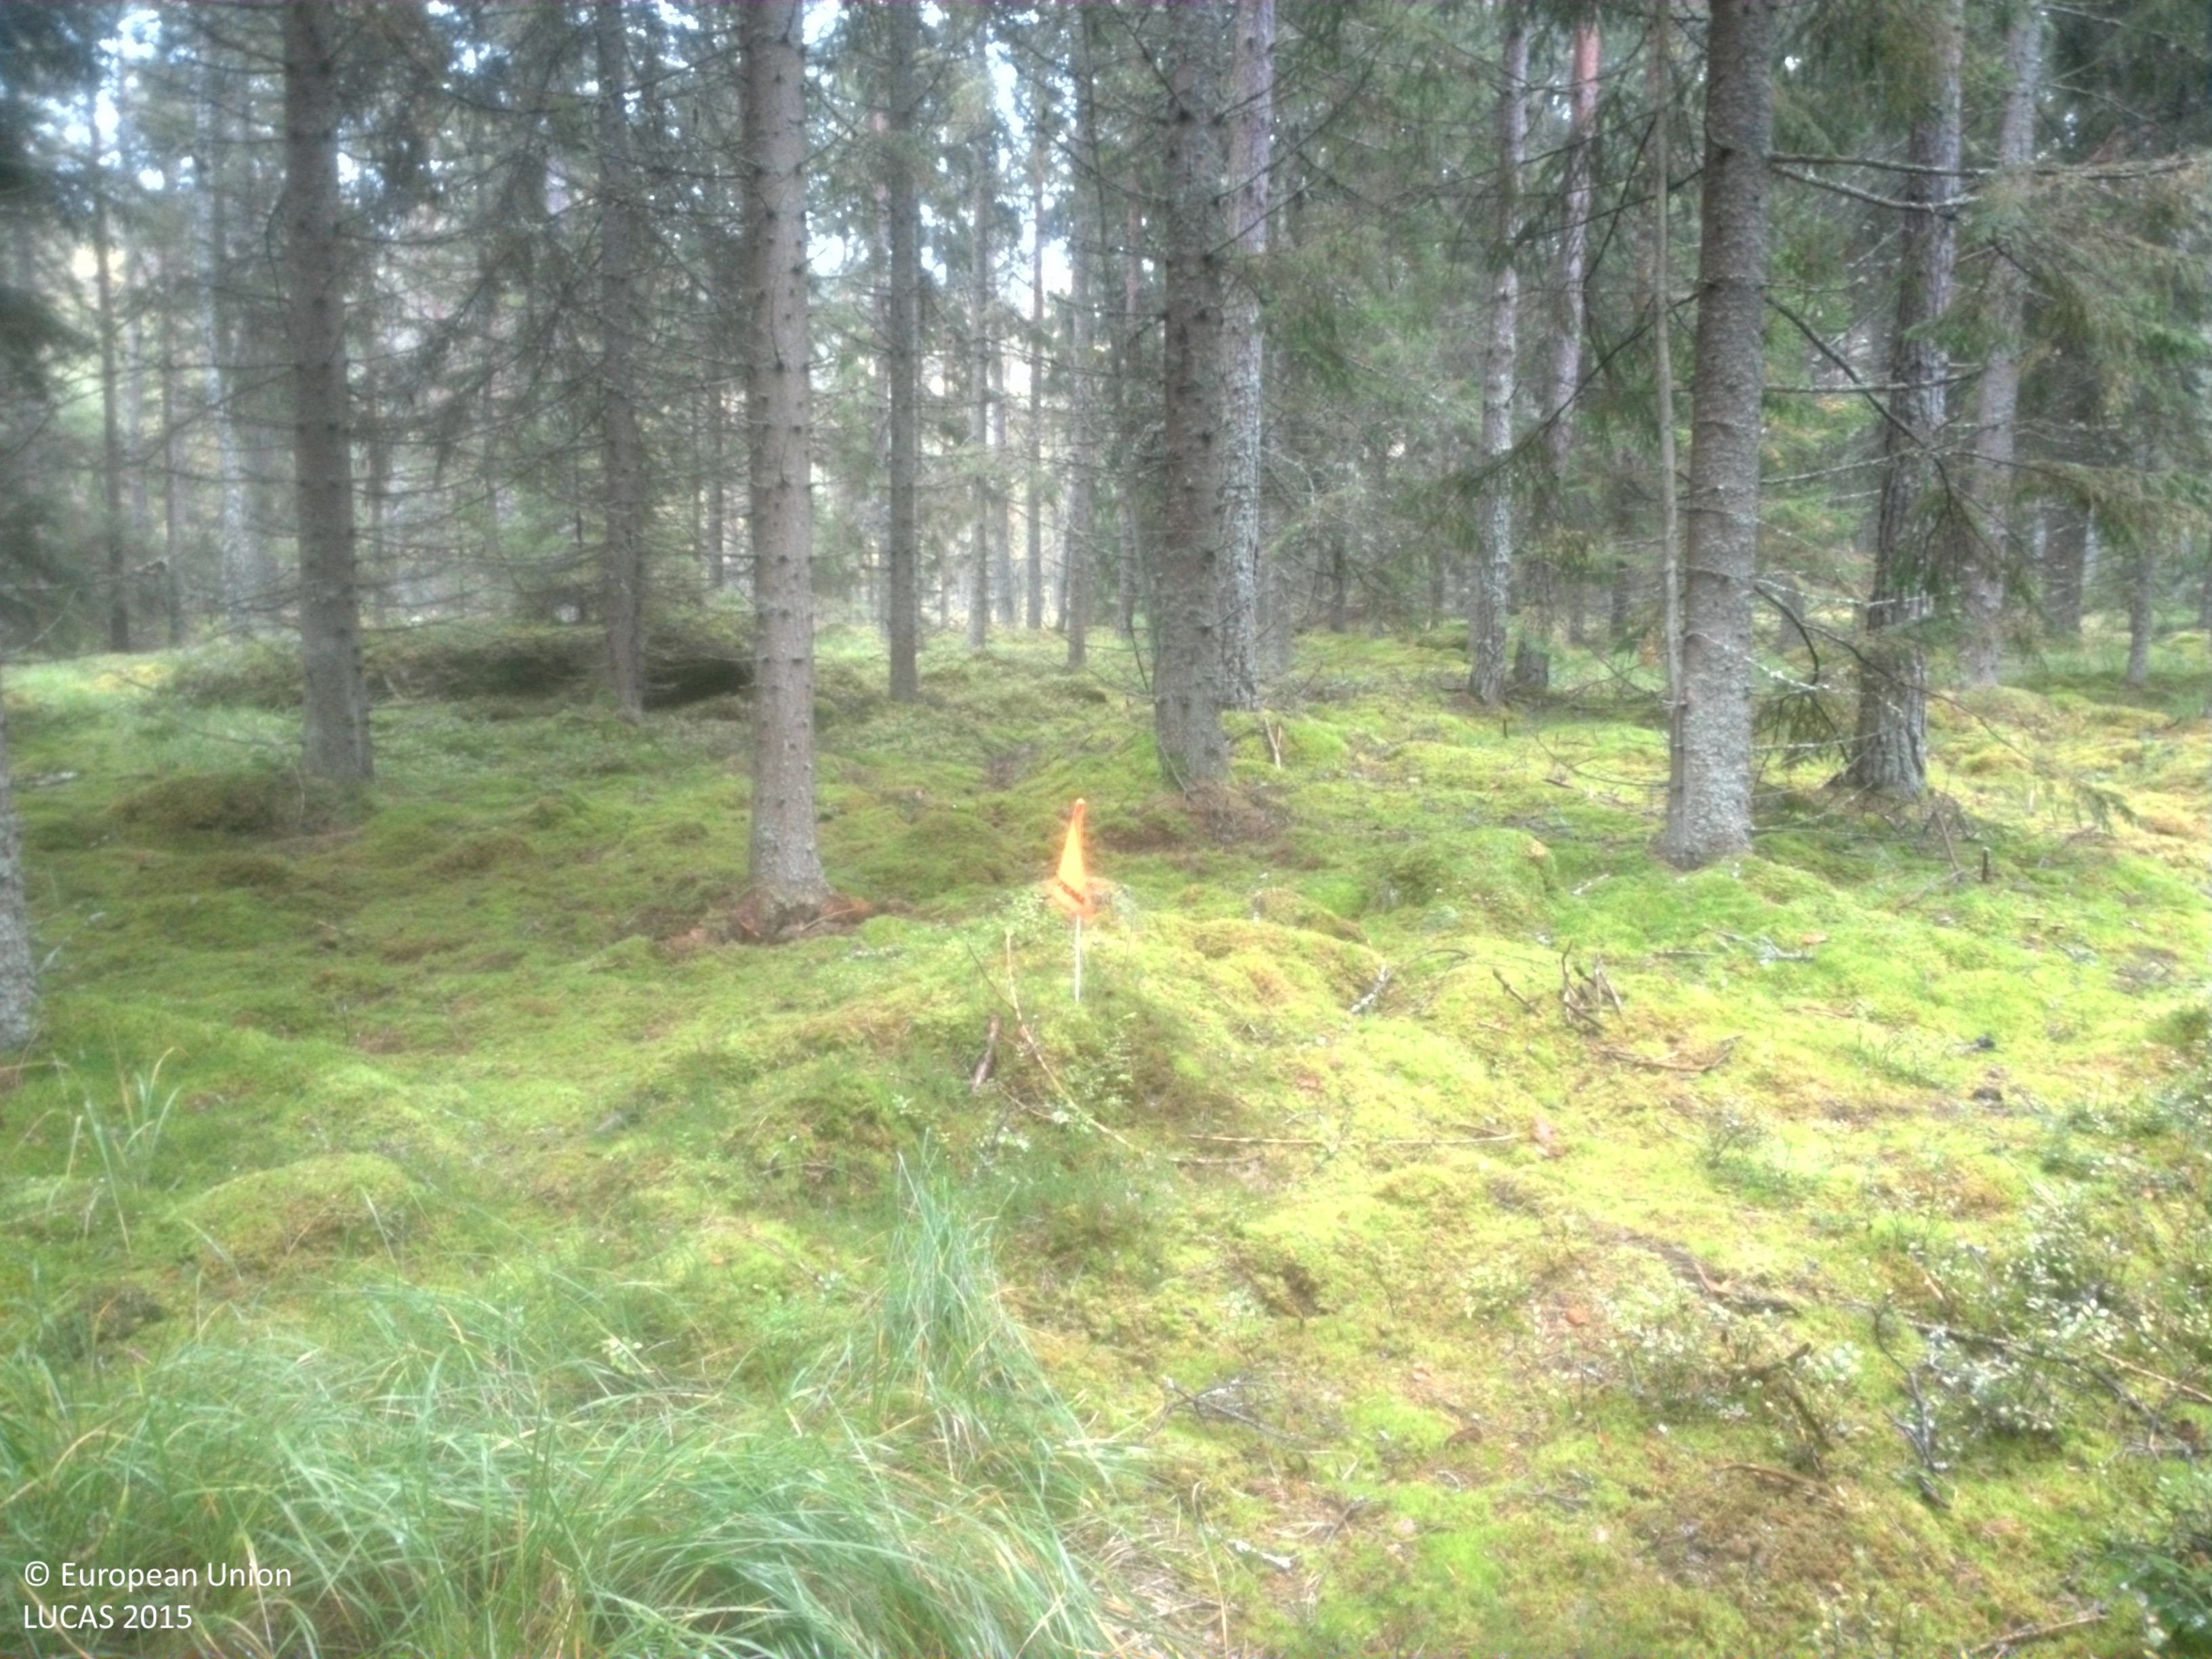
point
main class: Woodland
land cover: Spruce dominated coniferous woodland
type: boreal forest
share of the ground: 50 - 75 %
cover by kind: coniferous forest trees 50 %, lichens and mosses 40 %, shrubs 5 %, herbaceous plants 5 %
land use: Forestry
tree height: > 5 m
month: September
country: SE
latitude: 58.1812
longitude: 13.2087
